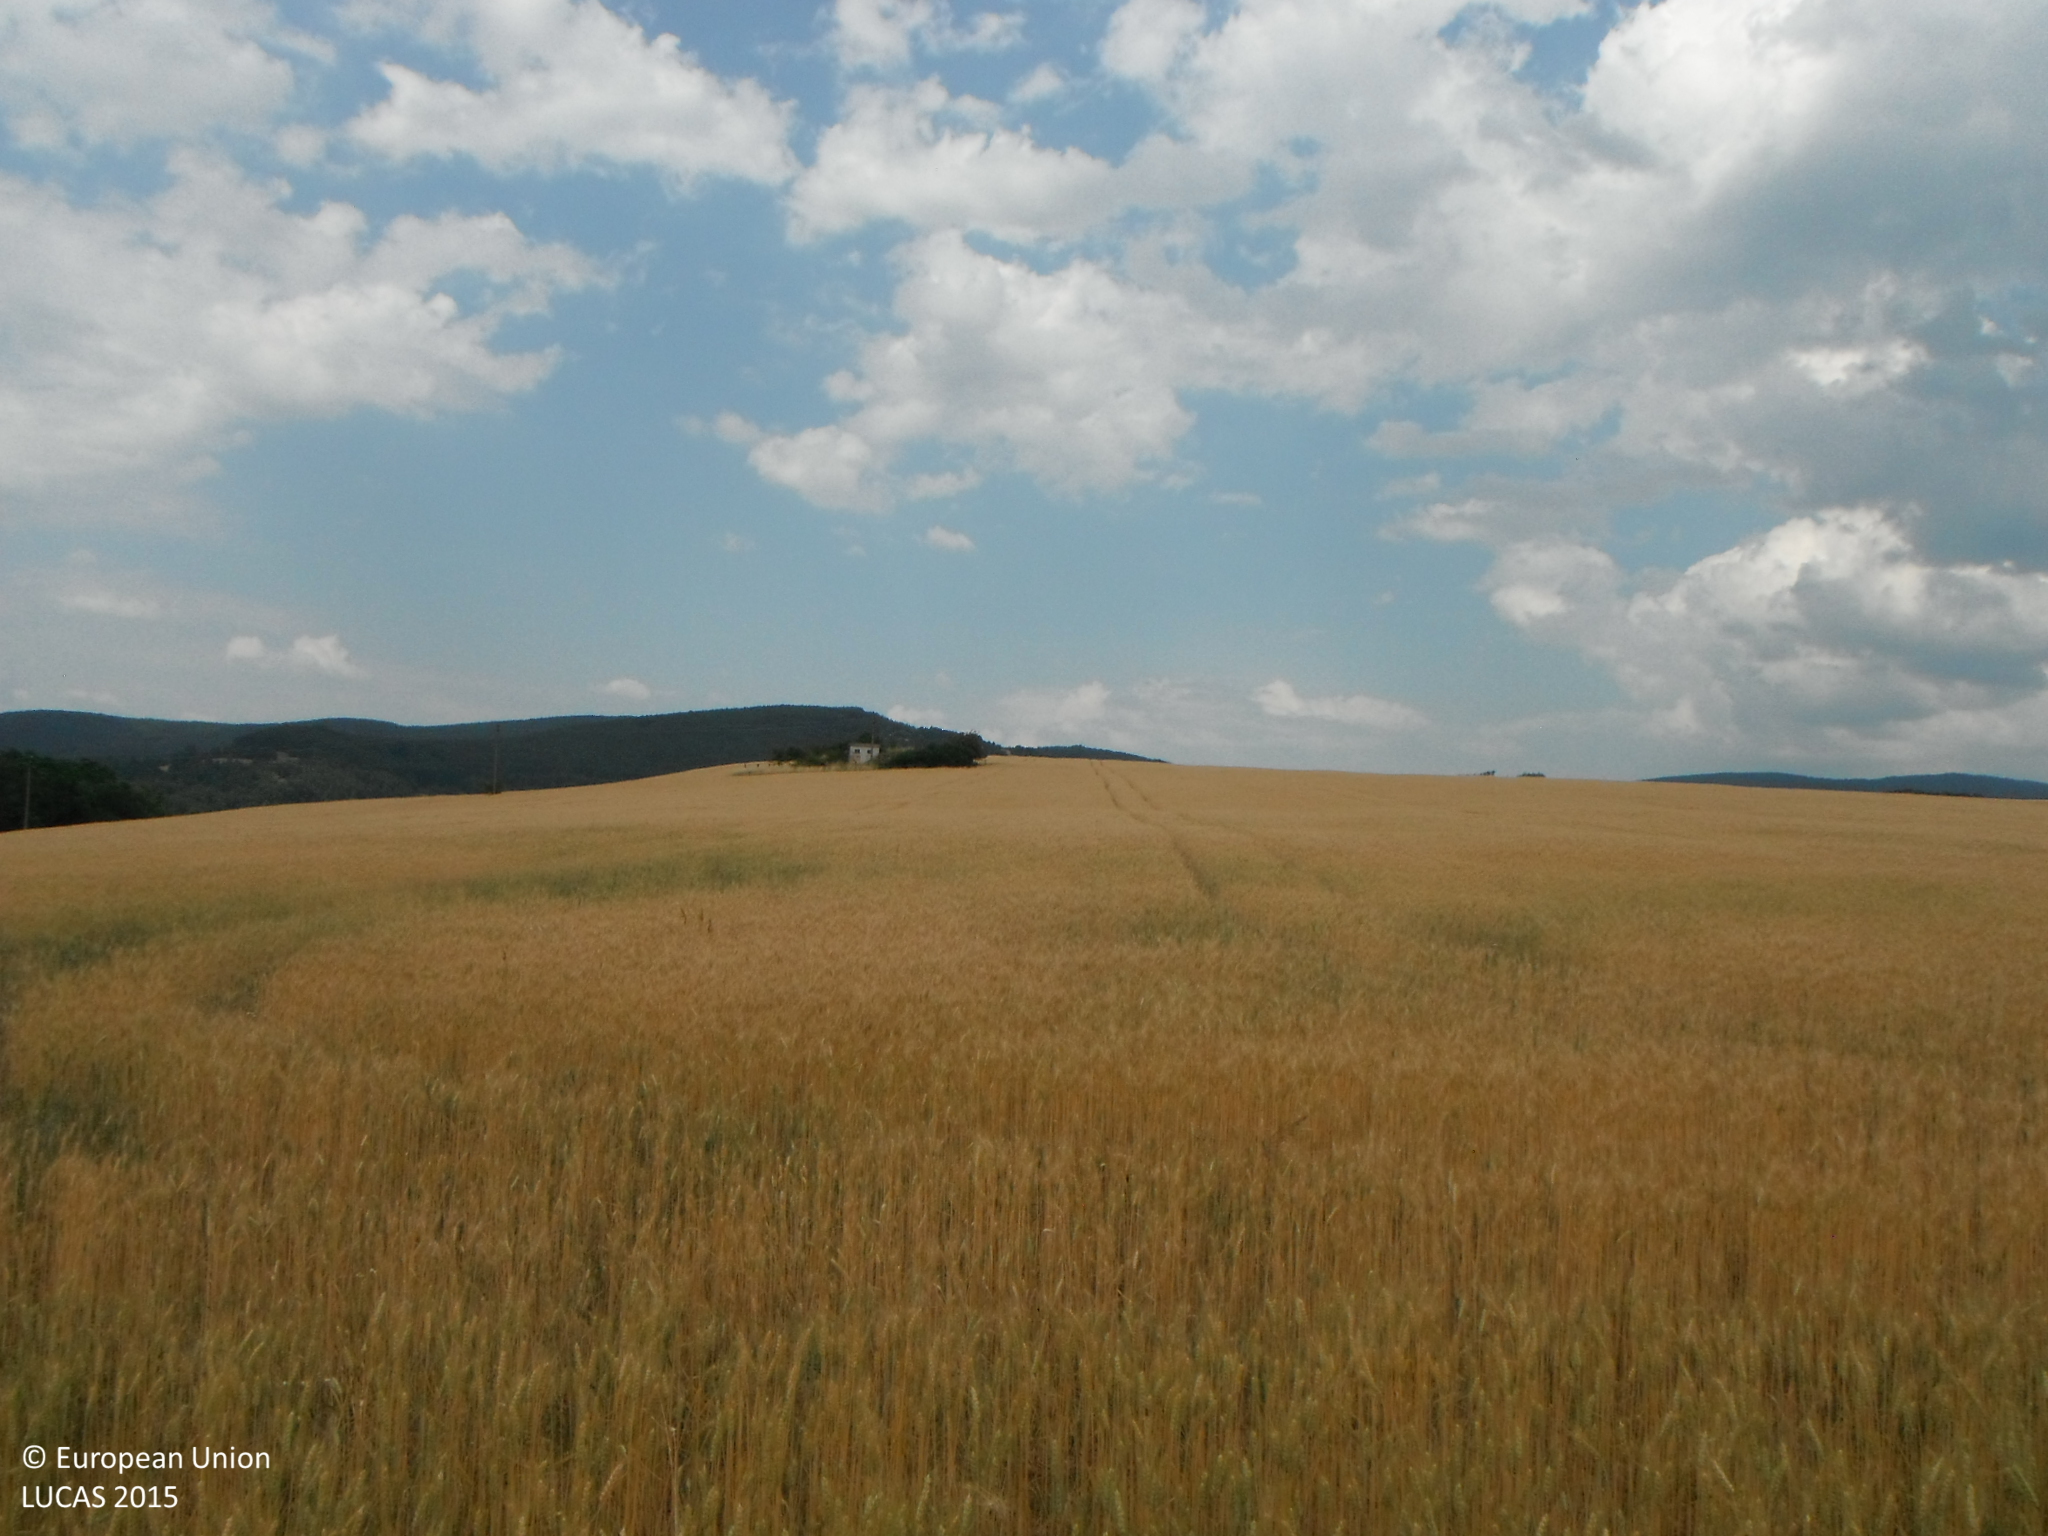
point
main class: Cropland
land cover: Common wheat
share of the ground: > 75 %
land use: Agriculture (excluding fallow land and kitchen gardens)
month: July
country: SK
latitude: 48.4201
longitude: 19.1697
